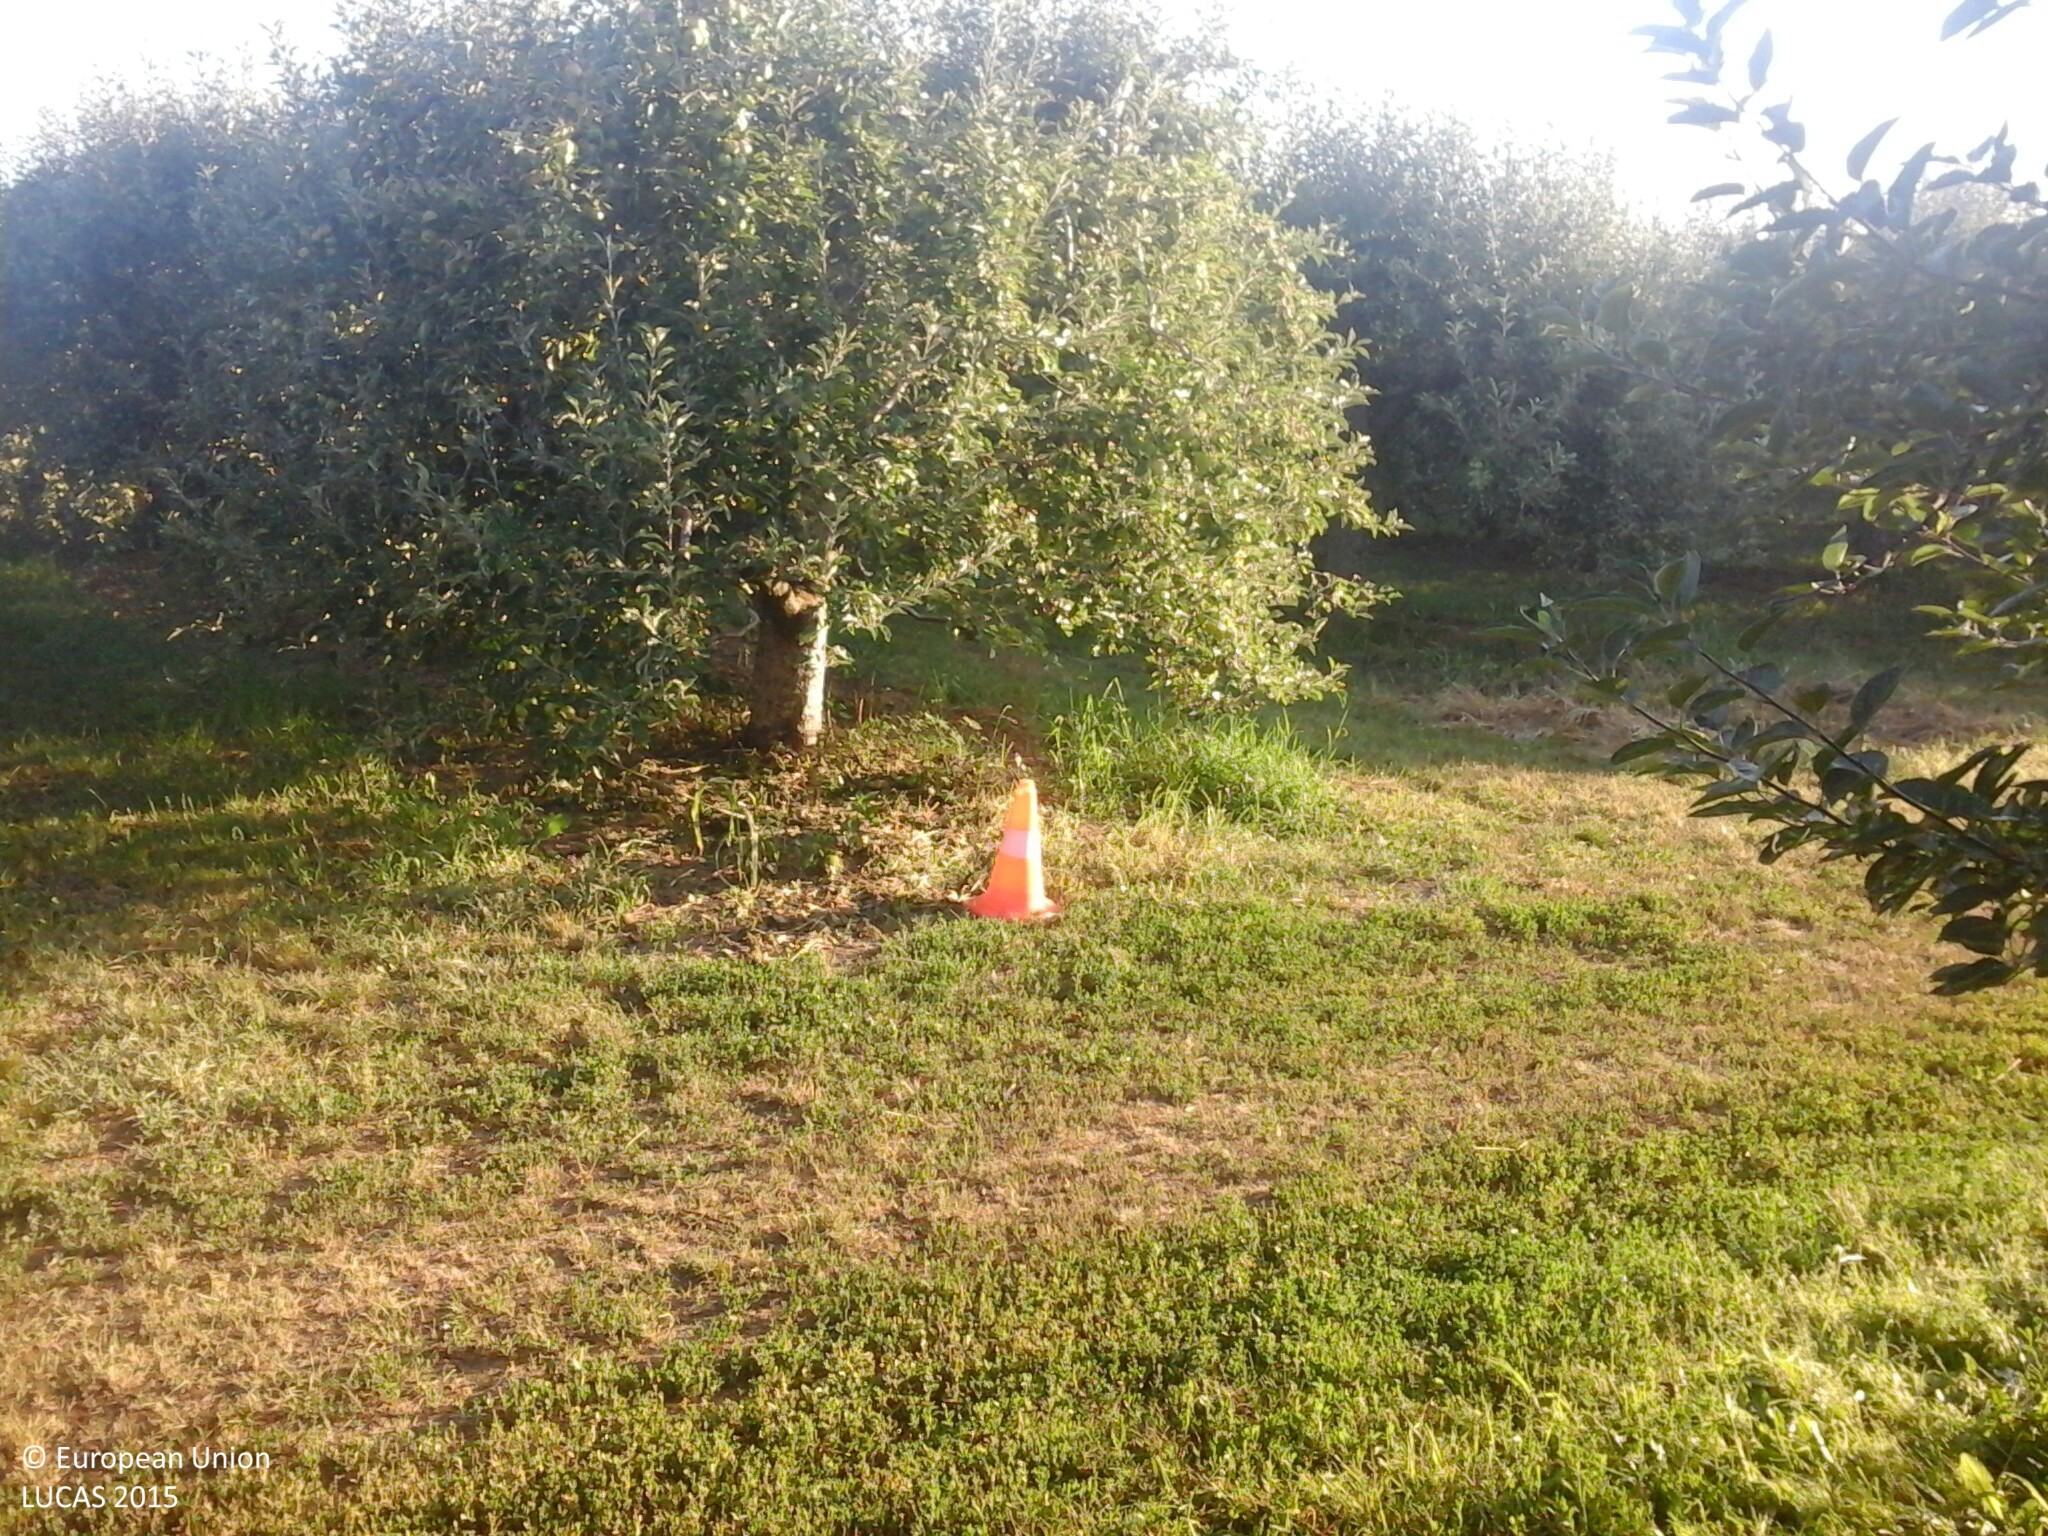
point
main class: Cropland
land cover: Apple fruit
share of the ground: 50 - 75 %
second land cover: Spontaneously vegetated surfaces
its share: 10 - 25 %
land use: Agriculture (excluding fallow land and kitchen gardens)
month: July
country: HU
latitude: 48.1148
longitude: 22.2938
